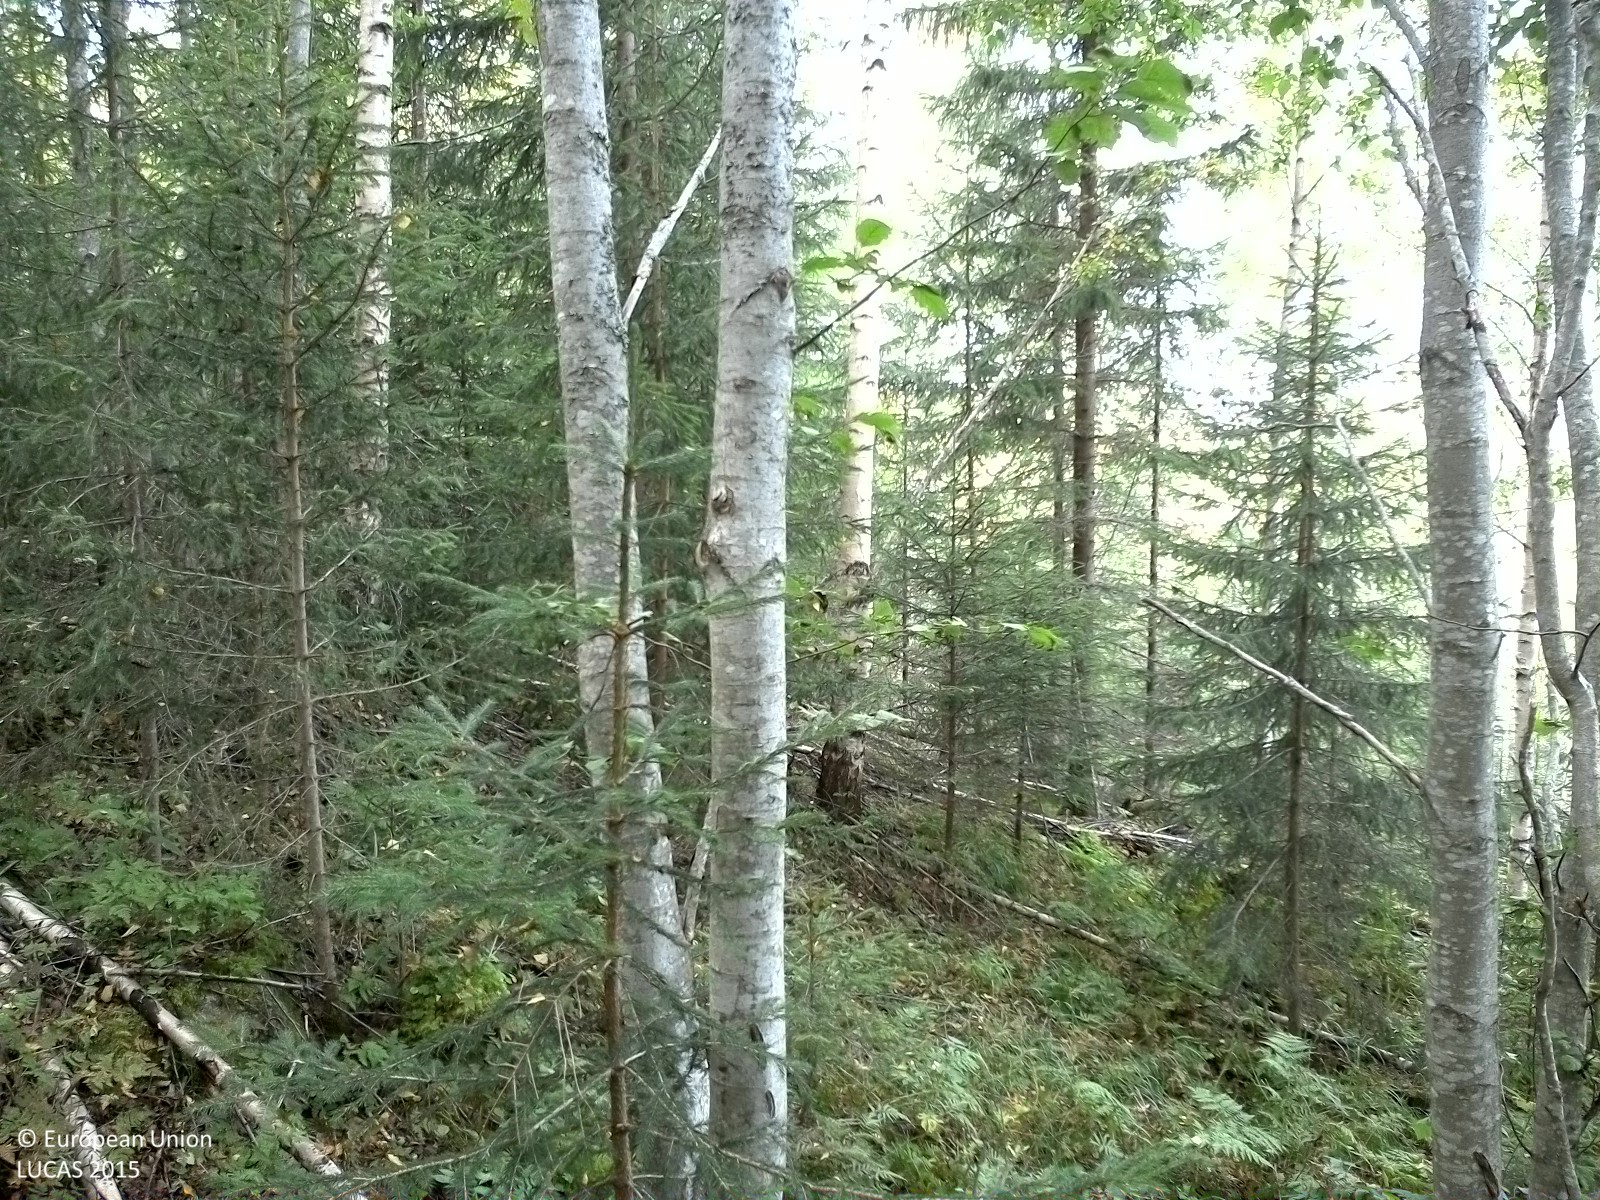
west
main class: Woodland
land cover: Broadleaved woodland
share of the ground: > 75 %
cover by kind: broadleaved forest trees 75 %, coniferous forest trees 15 %, shrubs 10 %
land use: Forestry
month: September
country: SE
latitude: 62.6231
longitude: 16.3527
